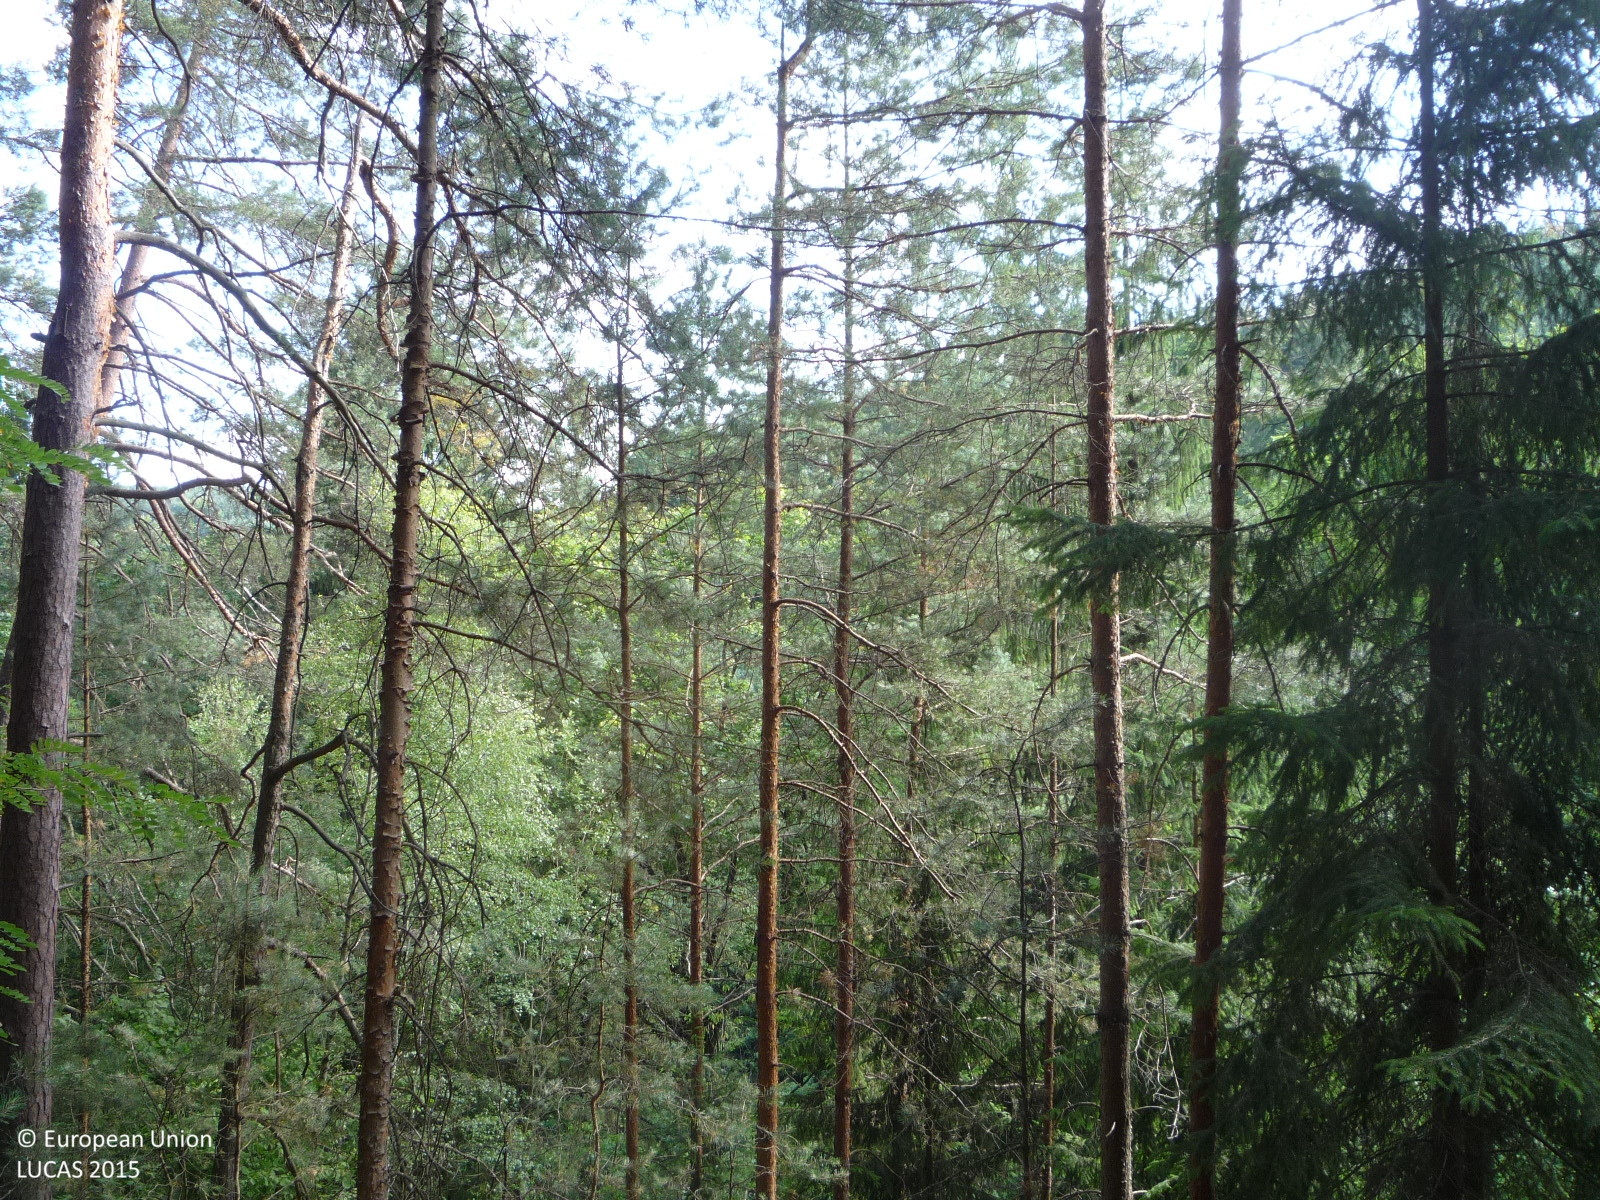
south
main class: Woodland
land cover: Pine dominated coniferous woodland
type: hemiboreal forest and nemoral coniferous forest and mixed broadleaved-coniferous forest
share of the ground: > 75 %
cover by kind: coniferous forest trees 85 %, broadleaved forest trees 10 %, unconsolidated bare surface 5 %
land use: Forestry
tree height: > 5 m
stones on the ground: < 10 %
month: July
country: CZ
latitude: 50.5987
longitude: 14.9617
